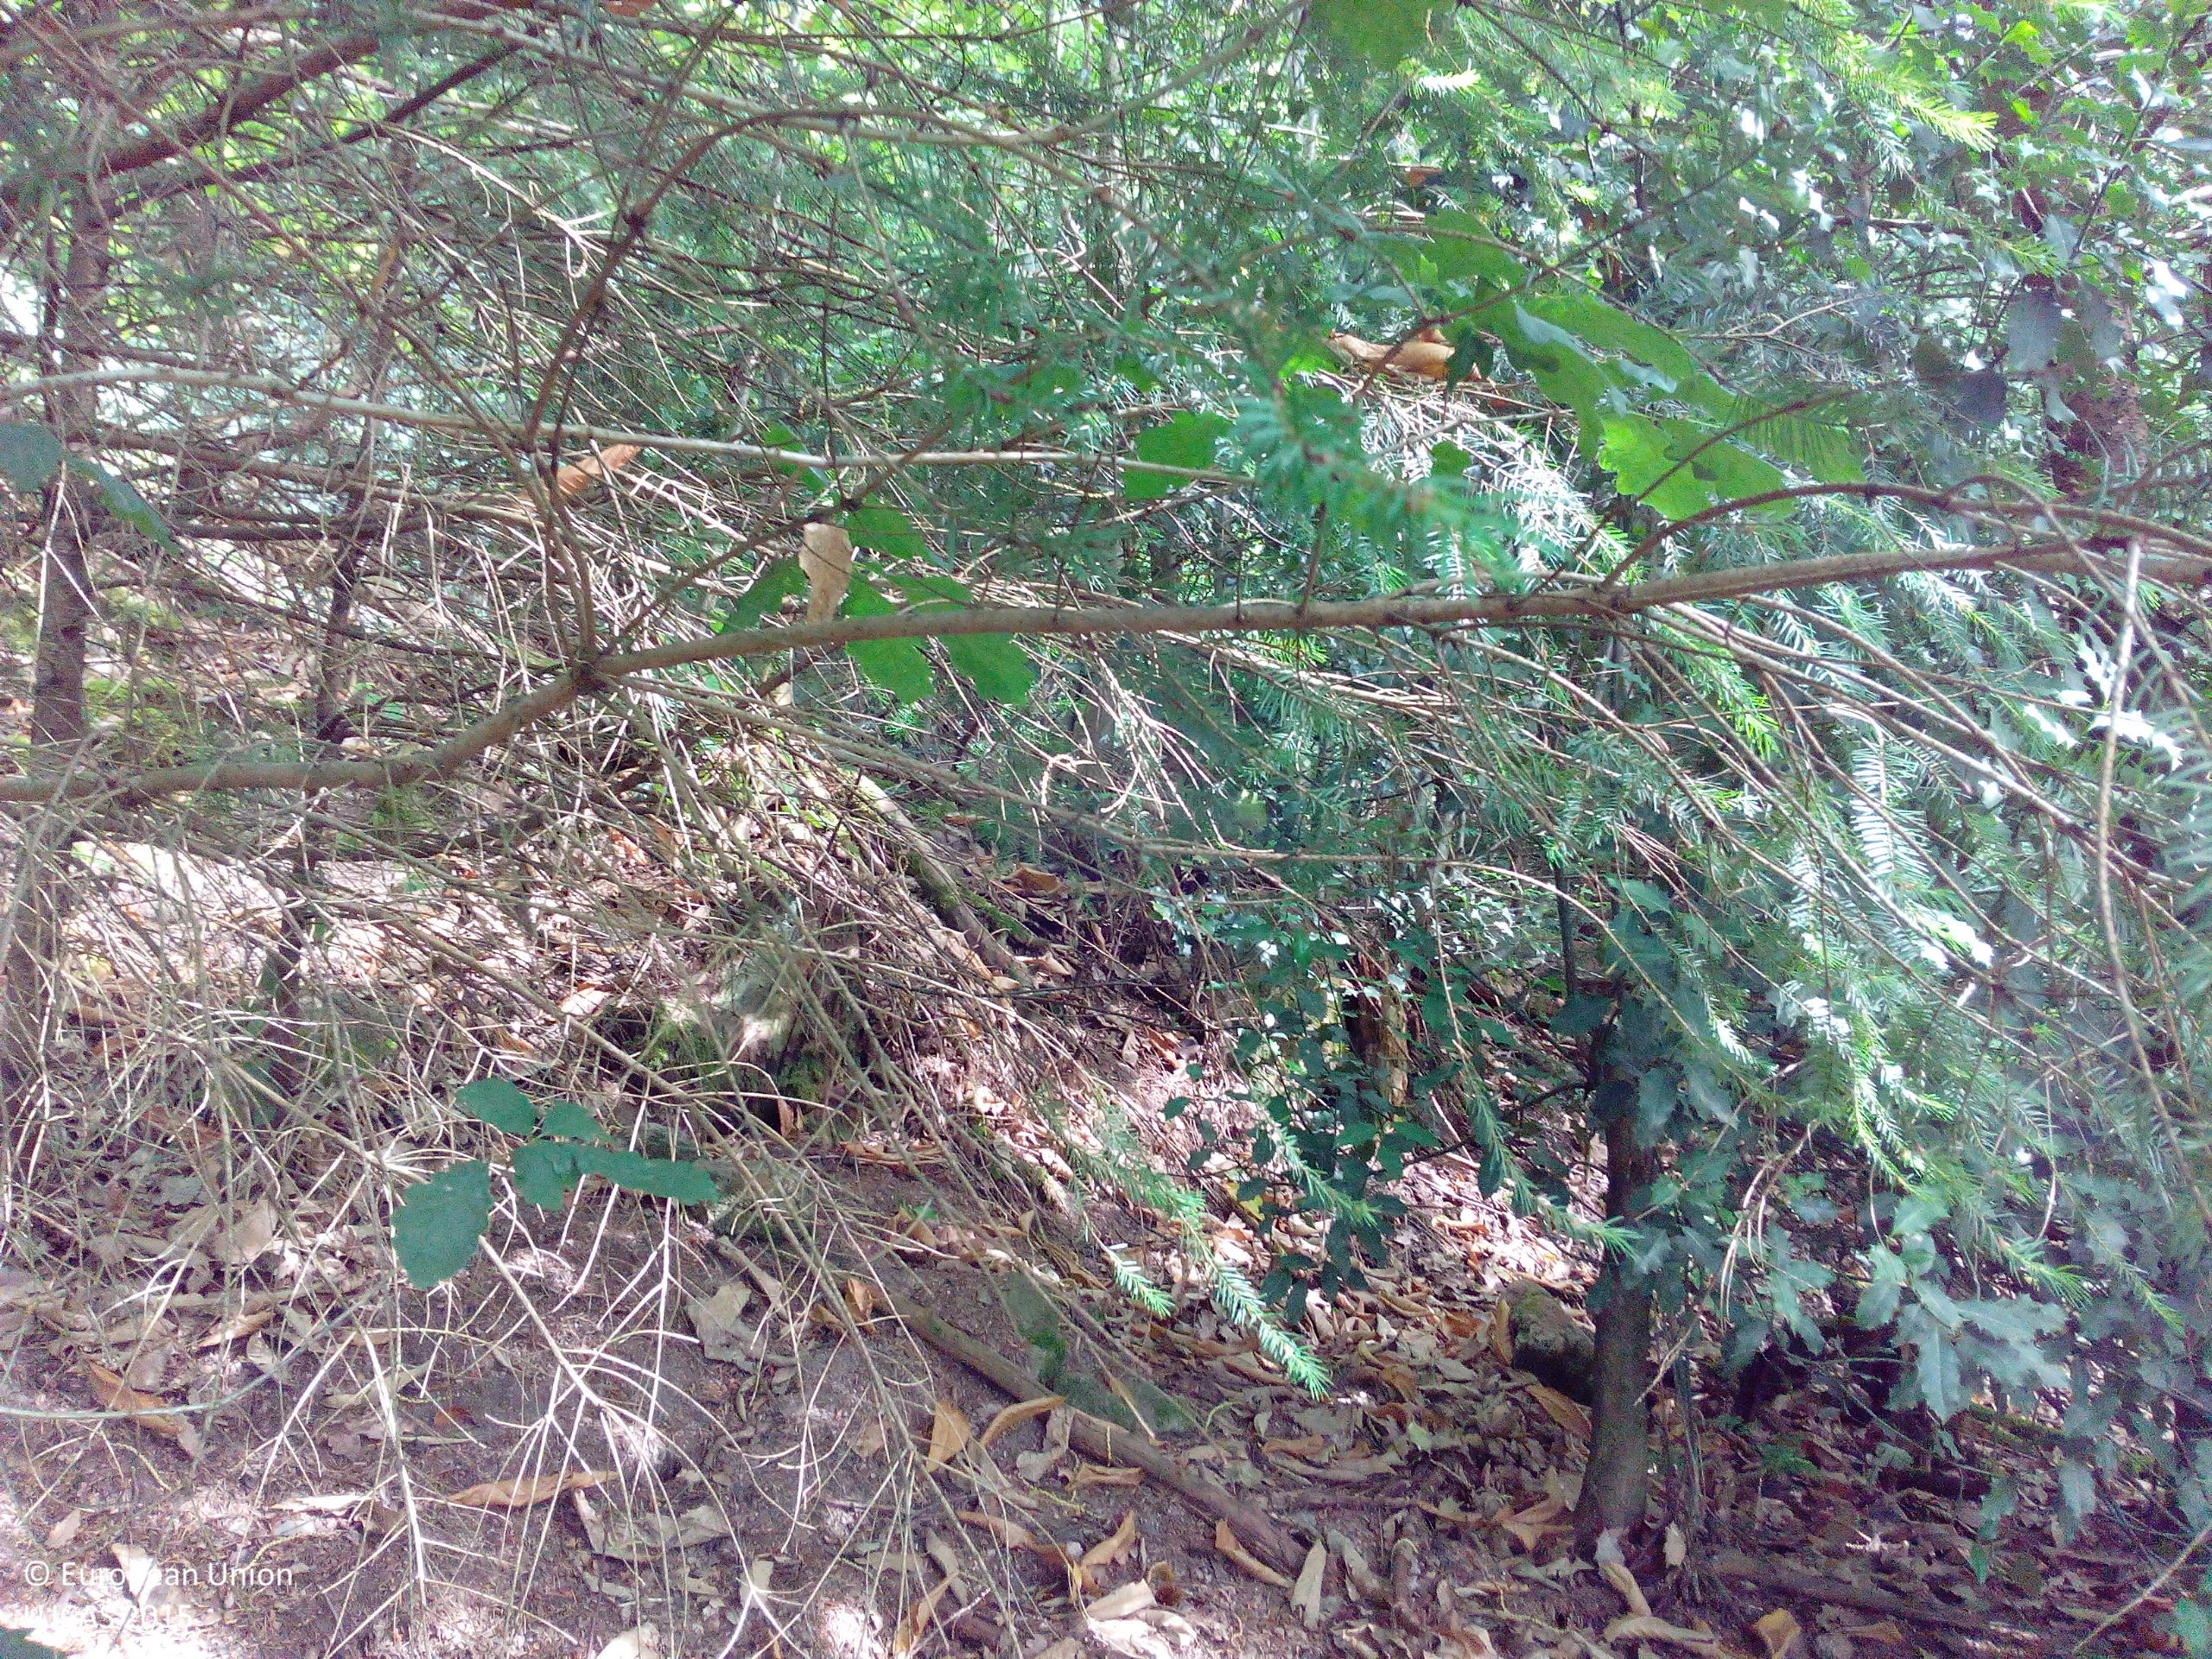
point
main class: Woodland
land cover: Spruce dominated mixed woodland
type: hemiboreal forest and nemoral coniferous forest and mixed broadleaved-coniferous forest
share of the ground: > 75 %
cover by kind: coniferous forest trees 60 %, broadleaved forest trees 40 %
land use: Forestry
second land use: Amenities, museums, leisure
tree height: > 5 m
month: June
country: DE
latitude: 48.7307
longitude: 8.1925
